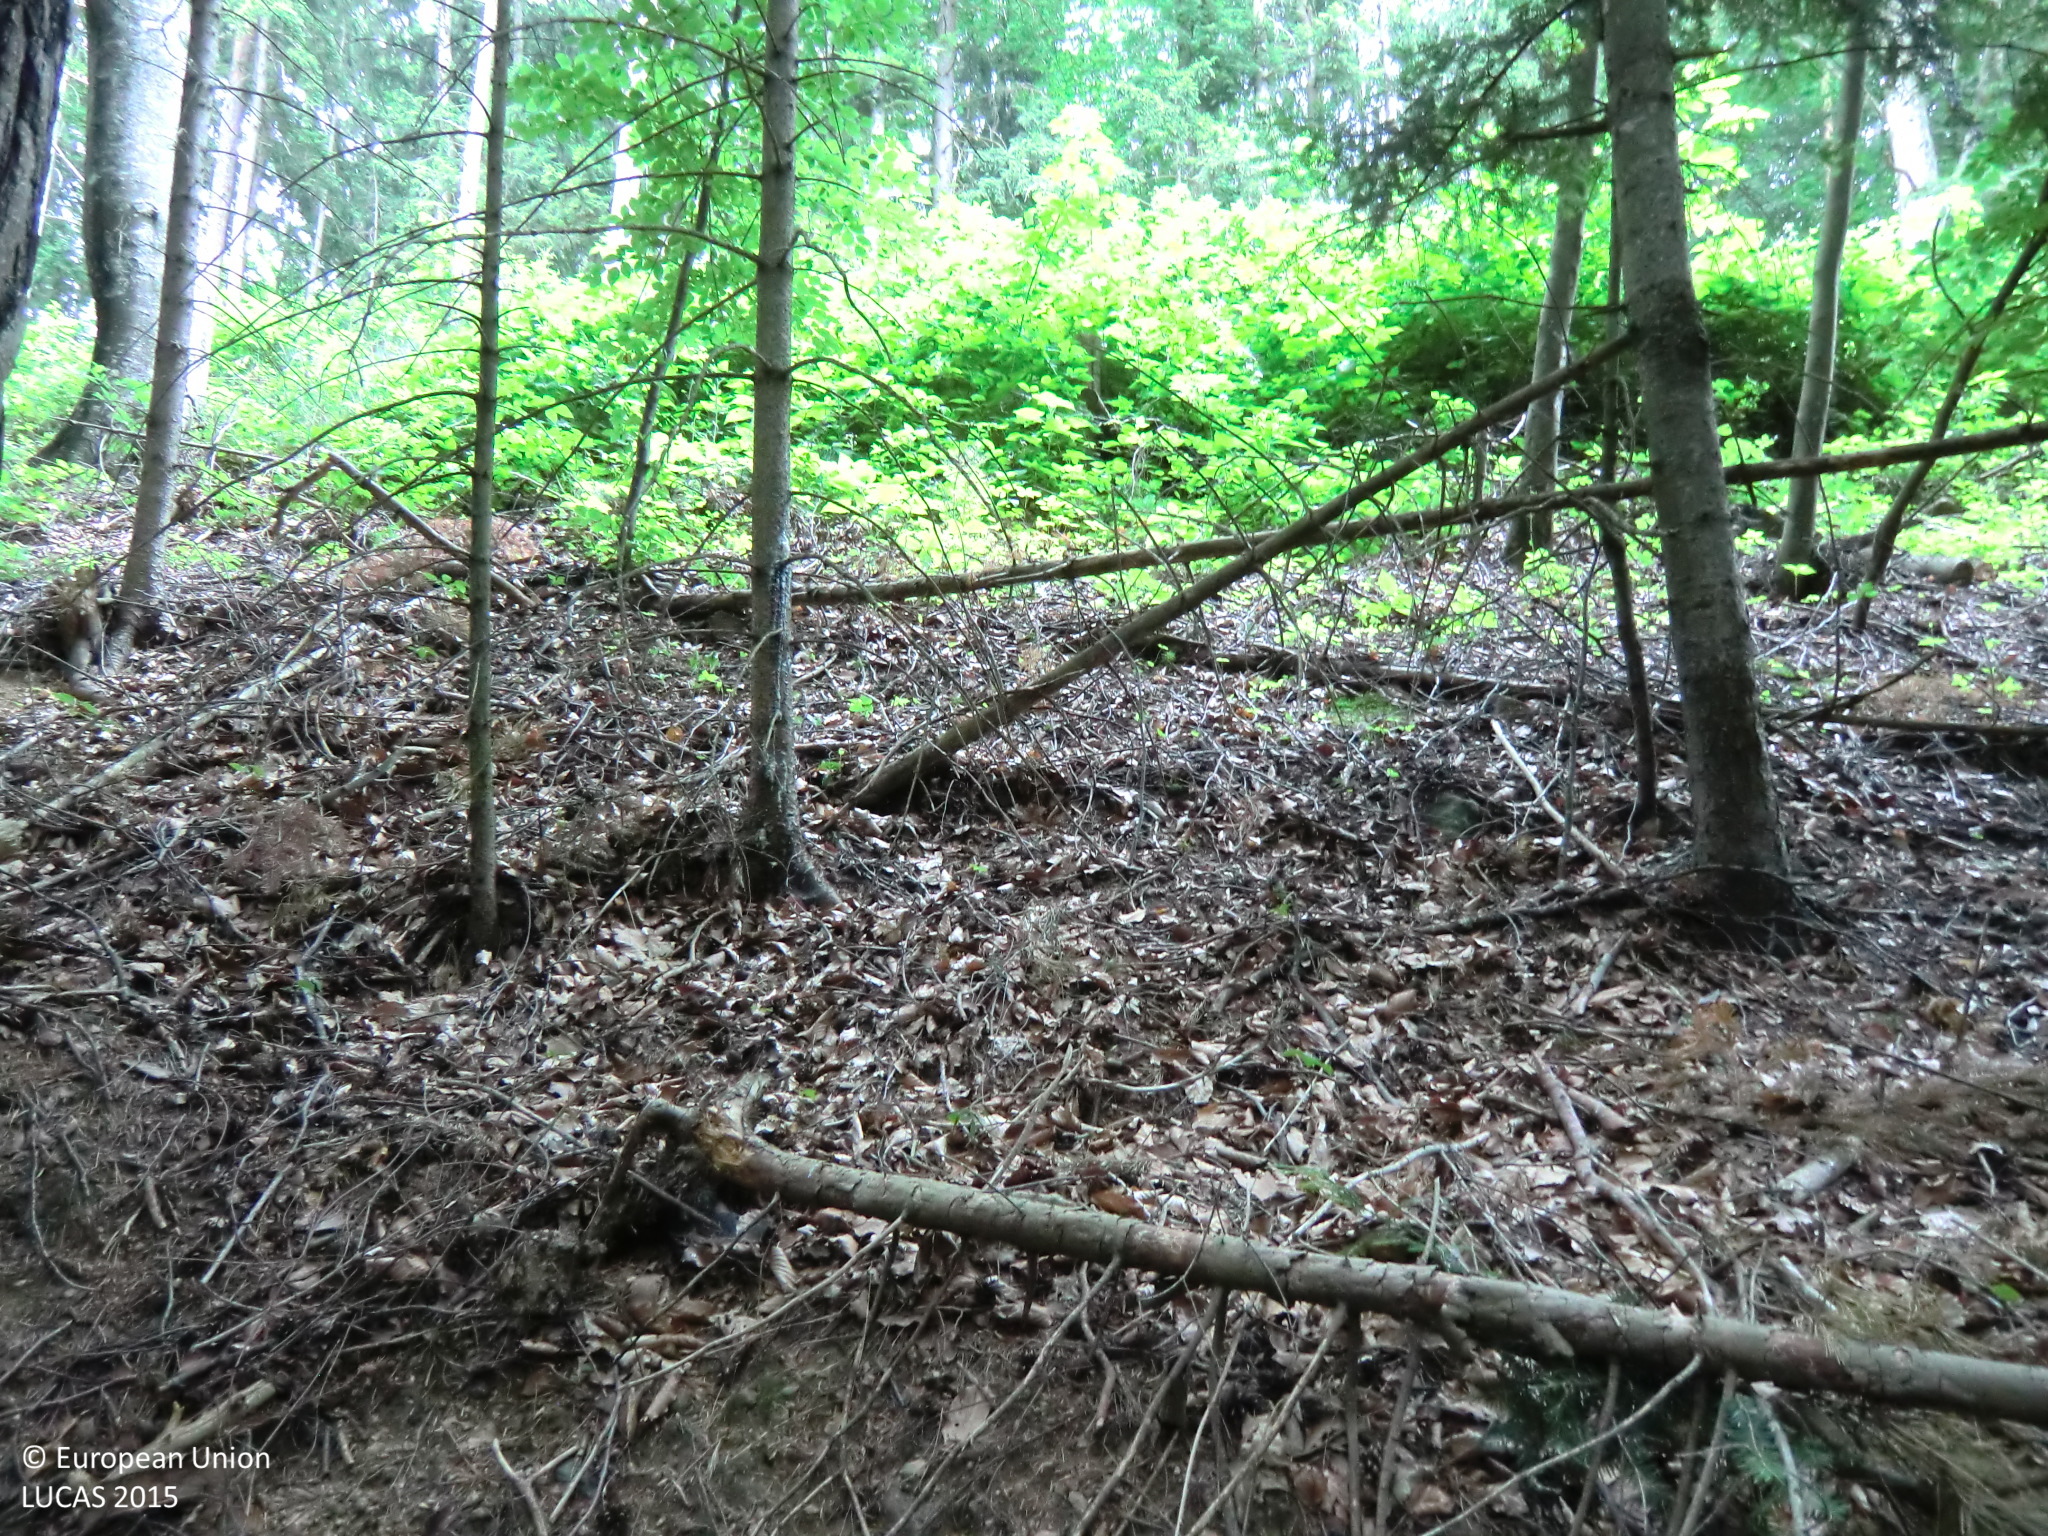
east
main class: Woodland
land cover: Spruce dominated mixed woodland
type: hemiboreal forest and nemoral coniferous forest and mixed broadleaved-coniferous forest
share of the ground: > 75 %
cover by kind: coniferous forest trees 45 %, broadleaved forest trees 45 %, unconsolidated bare surface 10 %
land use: Forestry
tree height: > 5 m
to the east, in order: Spruce dominated mixed woodland; Tracks; Spruce dominated mixed woodland; Grassland without tree/shrub cover; Paved roads, cycling and walking lanes; Grassland without tree/shrub cover
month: June
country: AT
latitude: 47.2616
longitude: 15.7498
